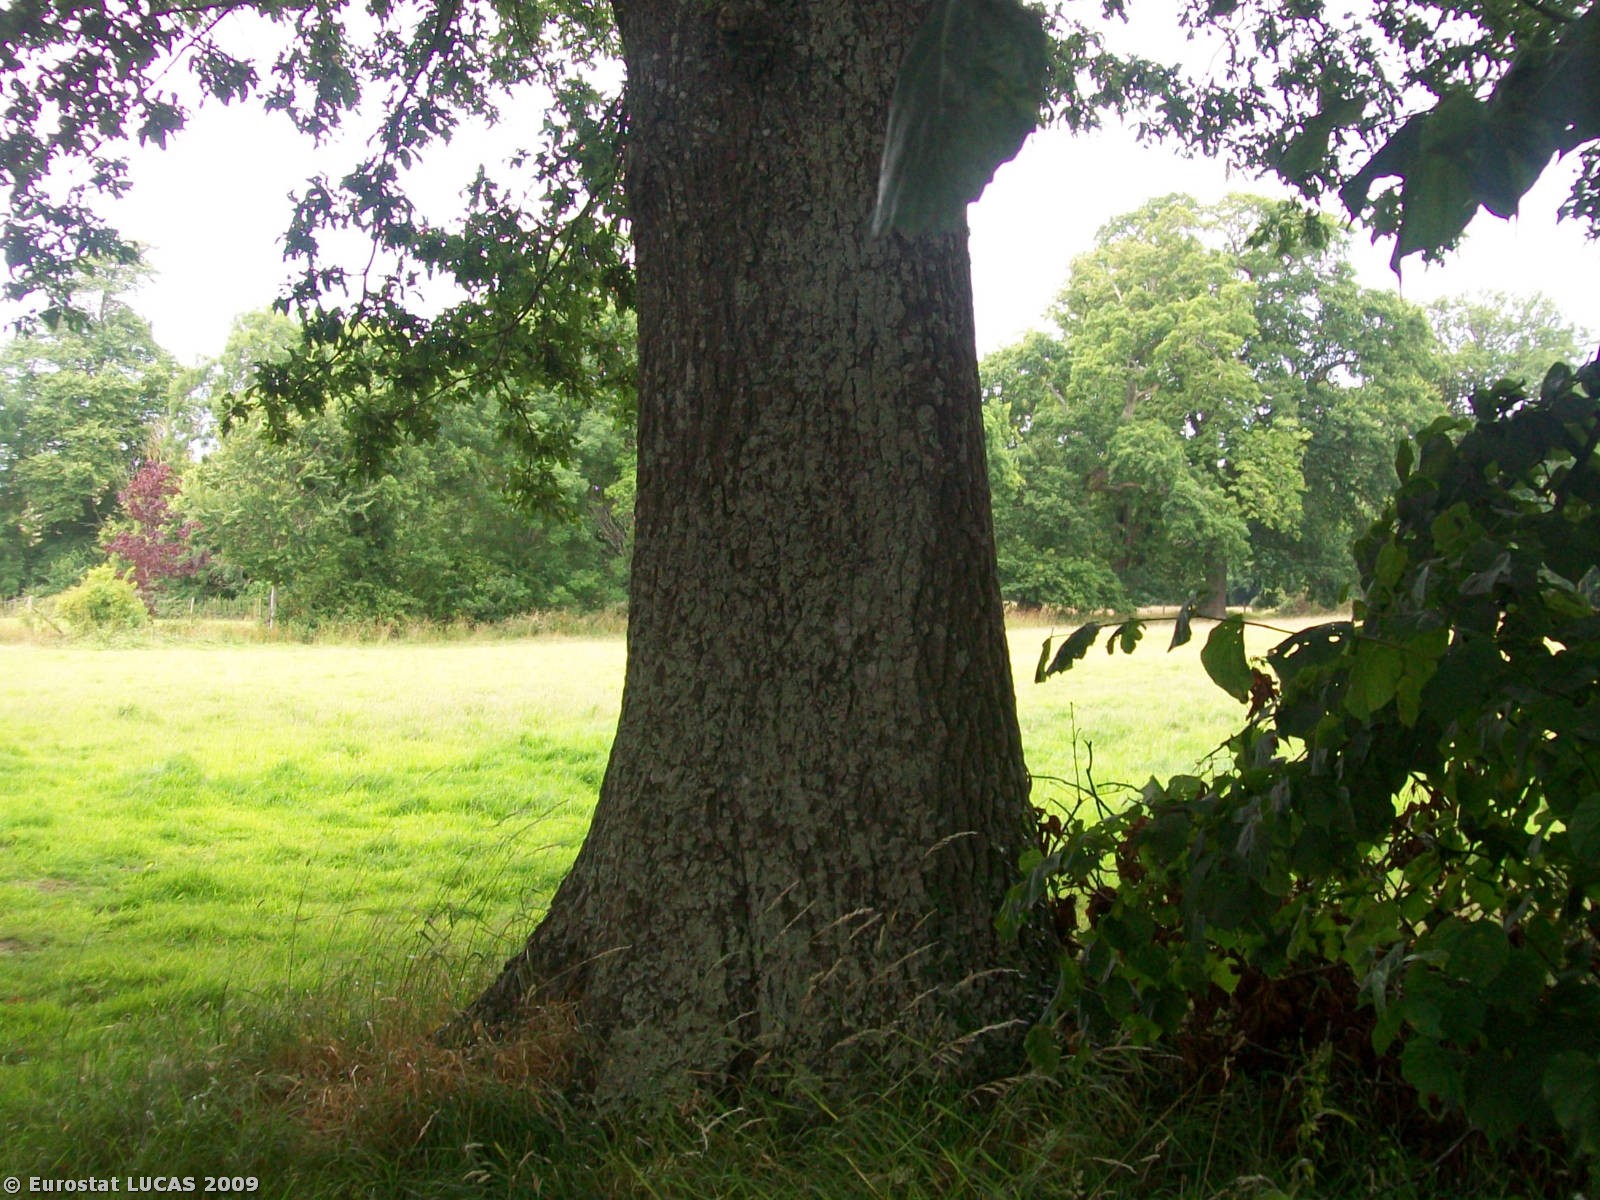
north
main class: Grassland
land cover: Grassland without tree/shrub cover
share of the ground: > 75 %
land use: Agriculture (excluding fallow land and kitchen gardens)
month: July
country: GB
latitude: 50.7384
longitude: -2.0898
